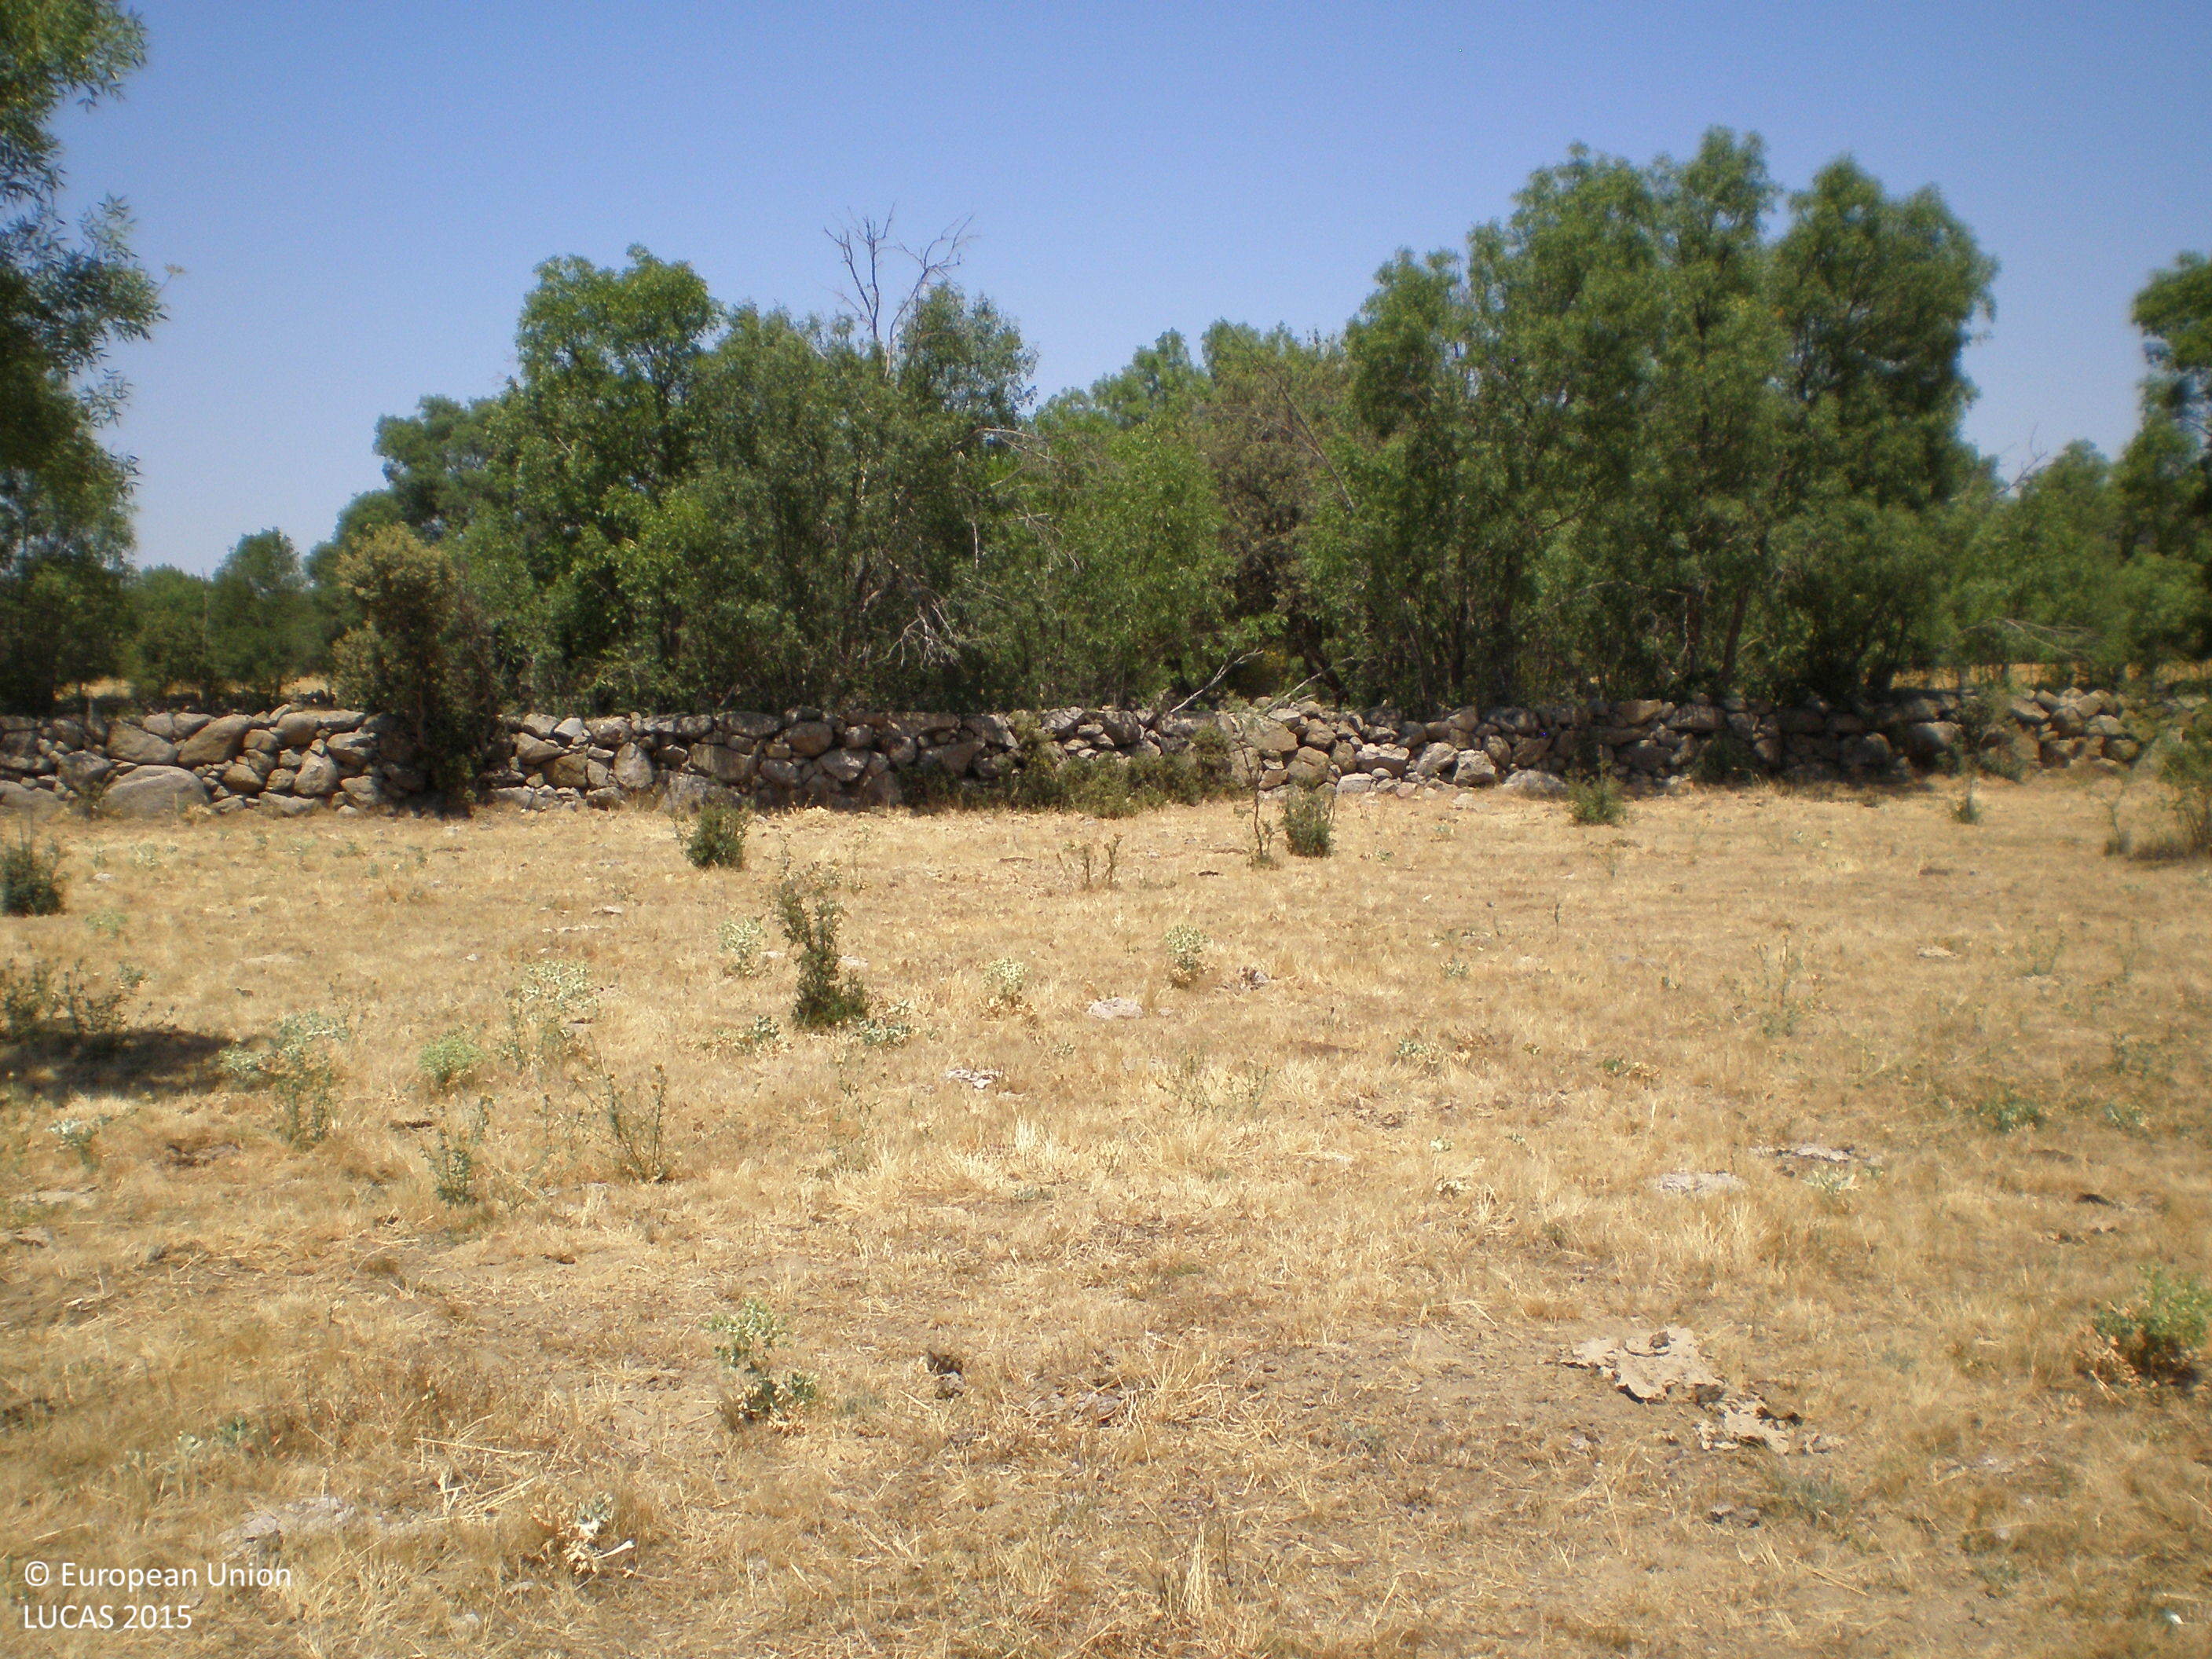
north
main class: Grassland
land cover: Grassland with sparse tree/shrub cover
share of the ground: > 75 %
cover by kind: herbaceous plants 95 %, broadleaved forest trees 5 %
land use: Agriculture (excluding fallow land and kitchen gardens)
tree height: < 5 m
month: July
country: ES
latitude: 40.4137
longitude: -5.5641
